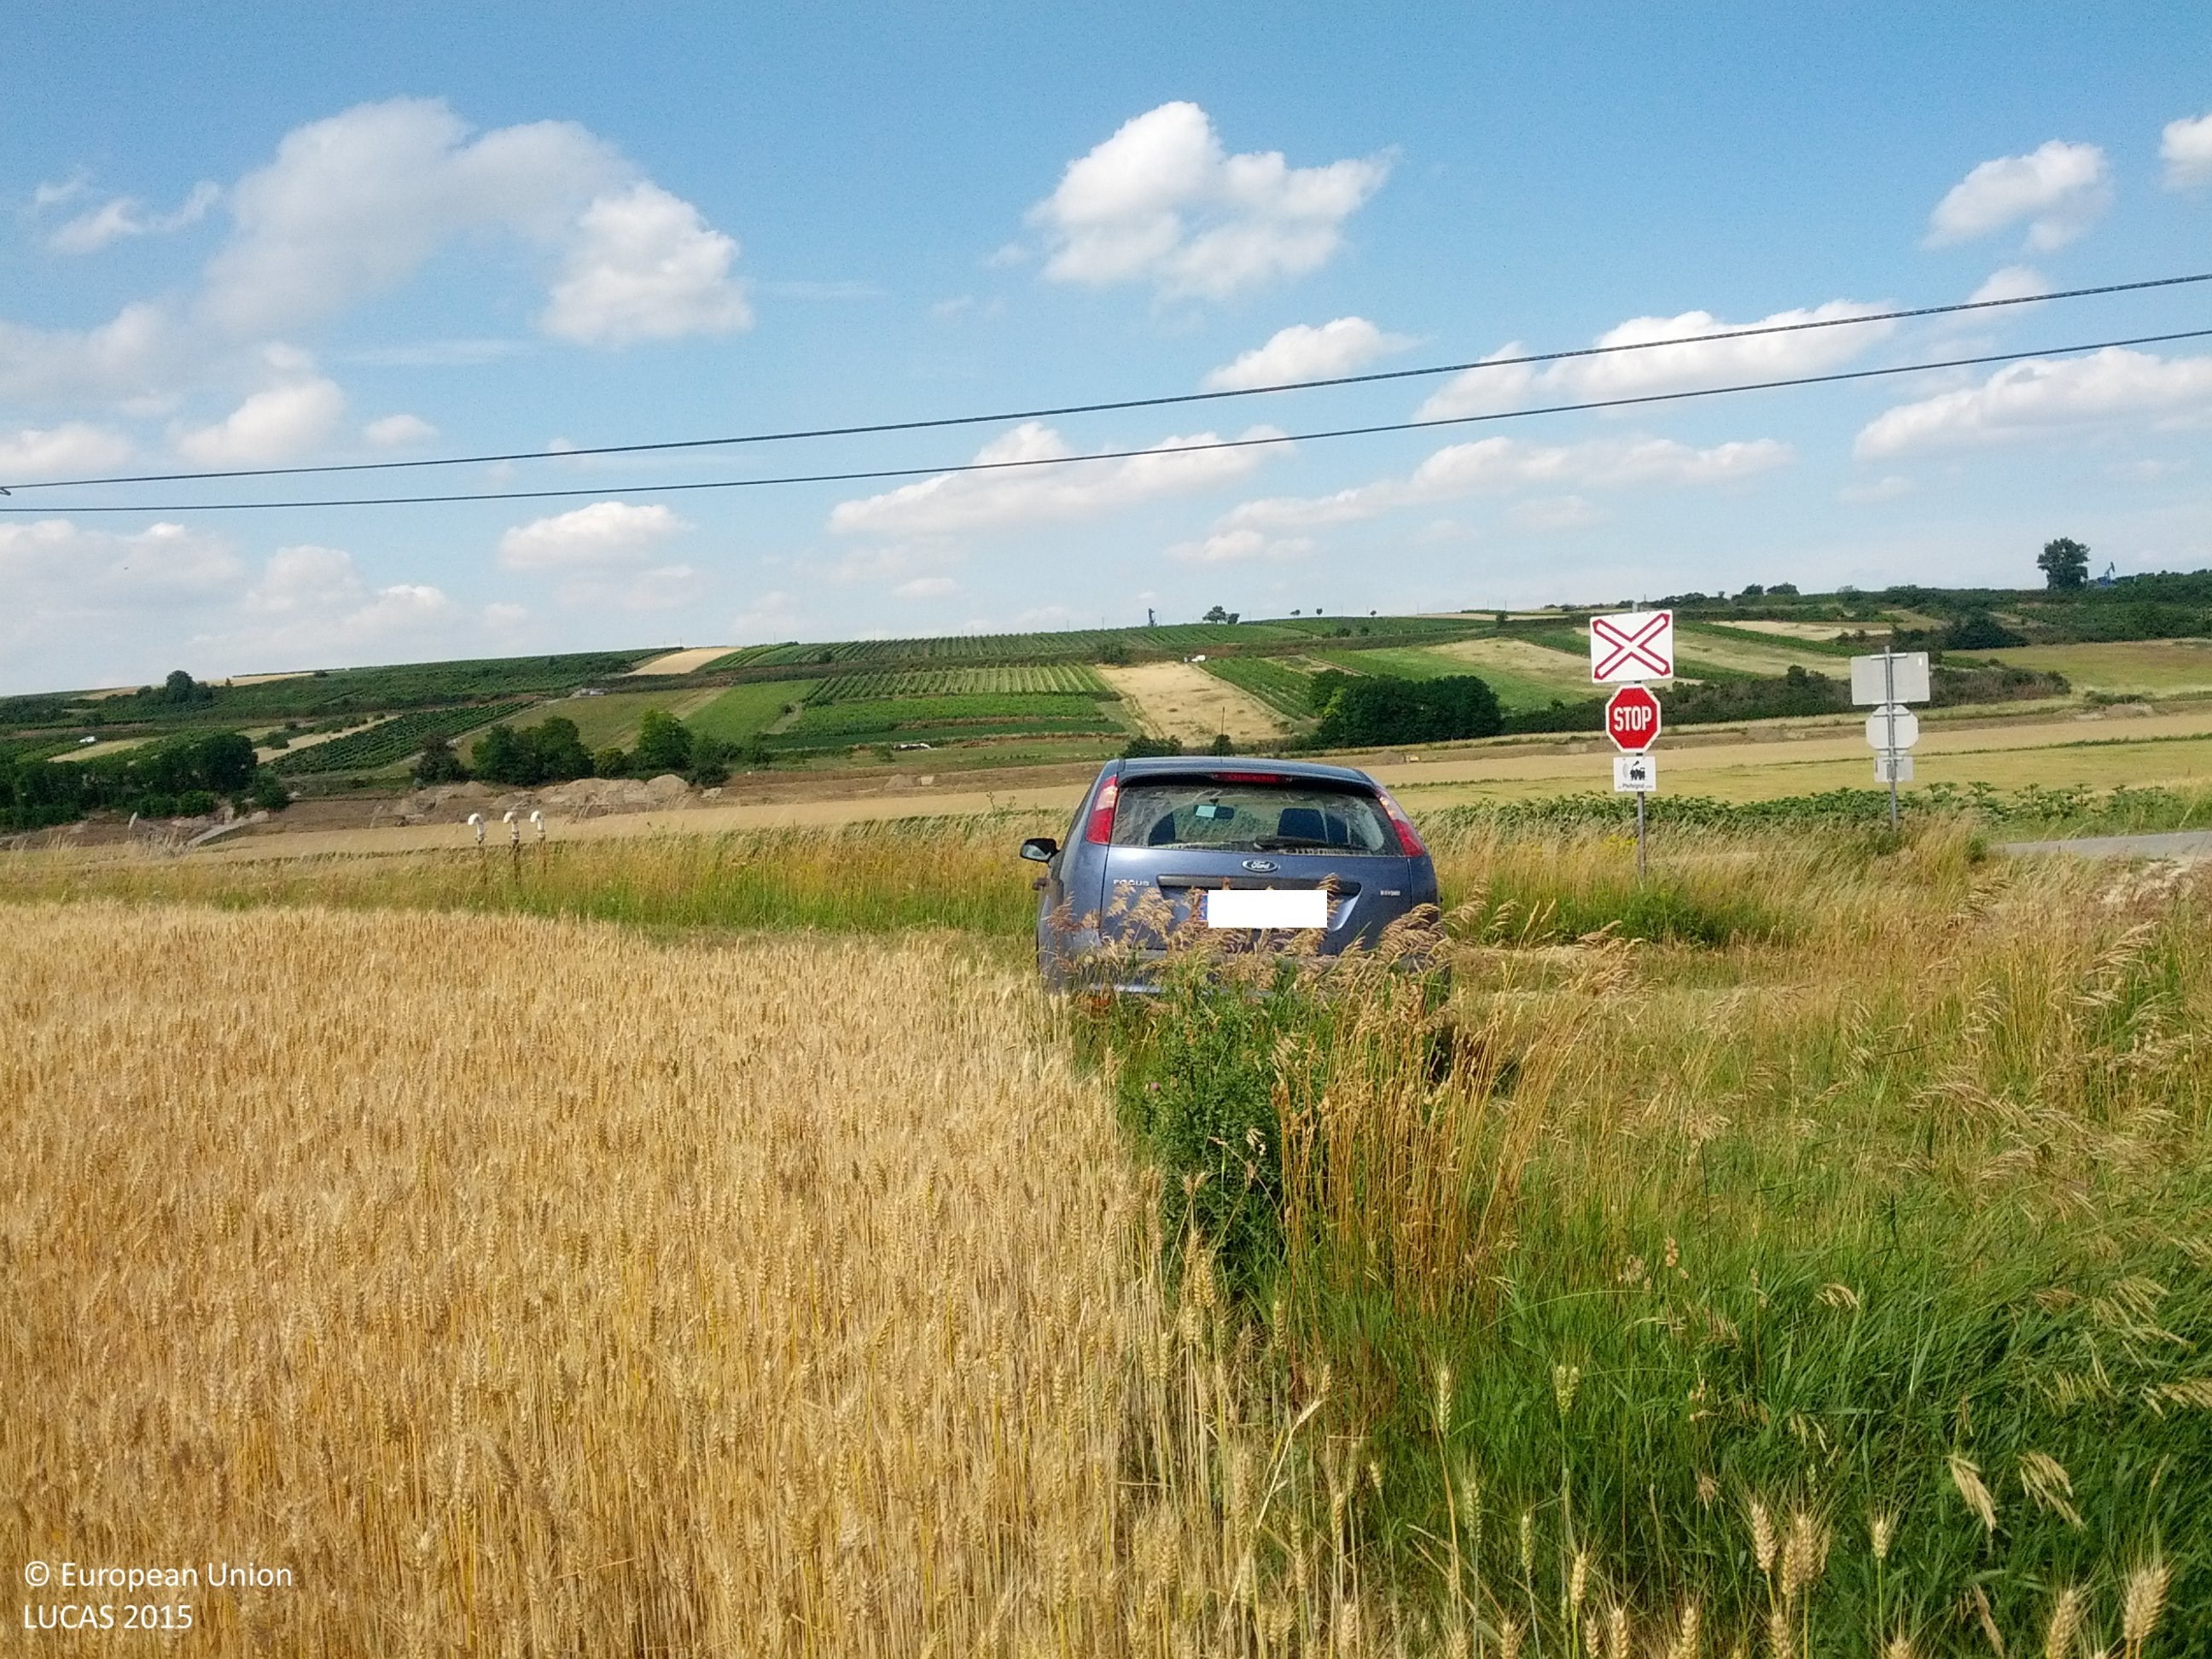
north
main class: Cropland
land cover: Common wheat
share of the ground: > 75 %
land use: Agriculture (excluding fallow land and kitchen gardens)
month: June
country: AT
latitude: 48.3830
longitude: 16.6633
